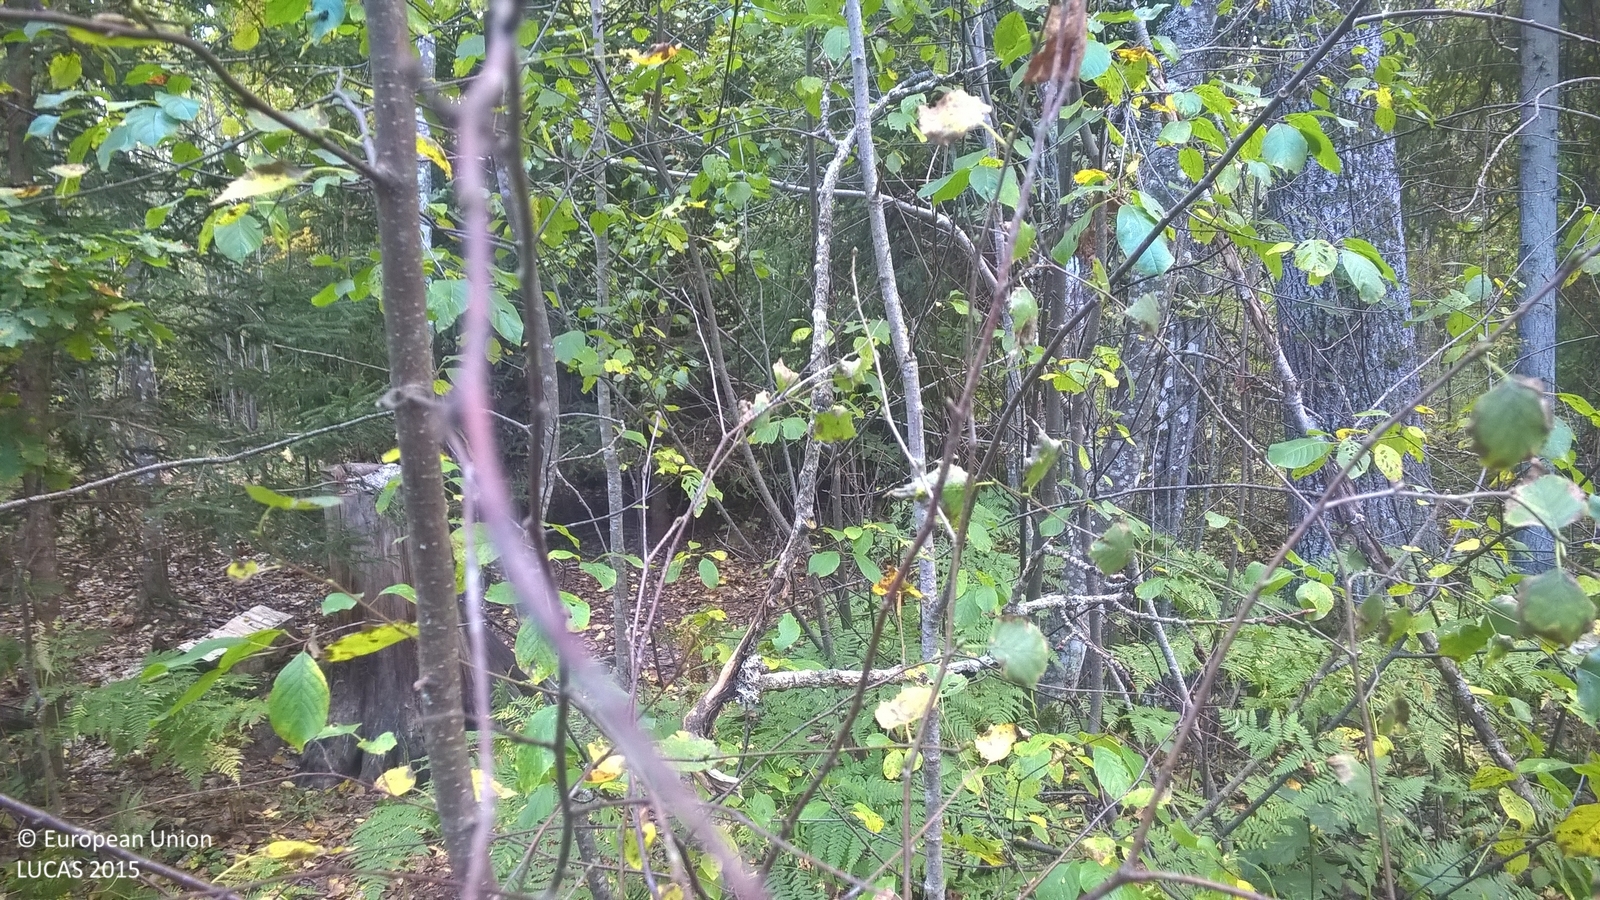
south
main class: Woodland
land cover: Spruce dominated mixed woodland
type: hemiboreal forest and nemoral coniferous forest and mixed broadleaved-coniferous forest
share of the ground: > 75 %
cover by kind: broadleaved forest trees 45 %, coniferous forest trees 30 %, lichens and mosses 25 %
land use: Forestry
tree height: > 5 m
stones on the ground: < 10 %
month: September
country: LV
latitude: 57.6473
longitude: 25.6154
